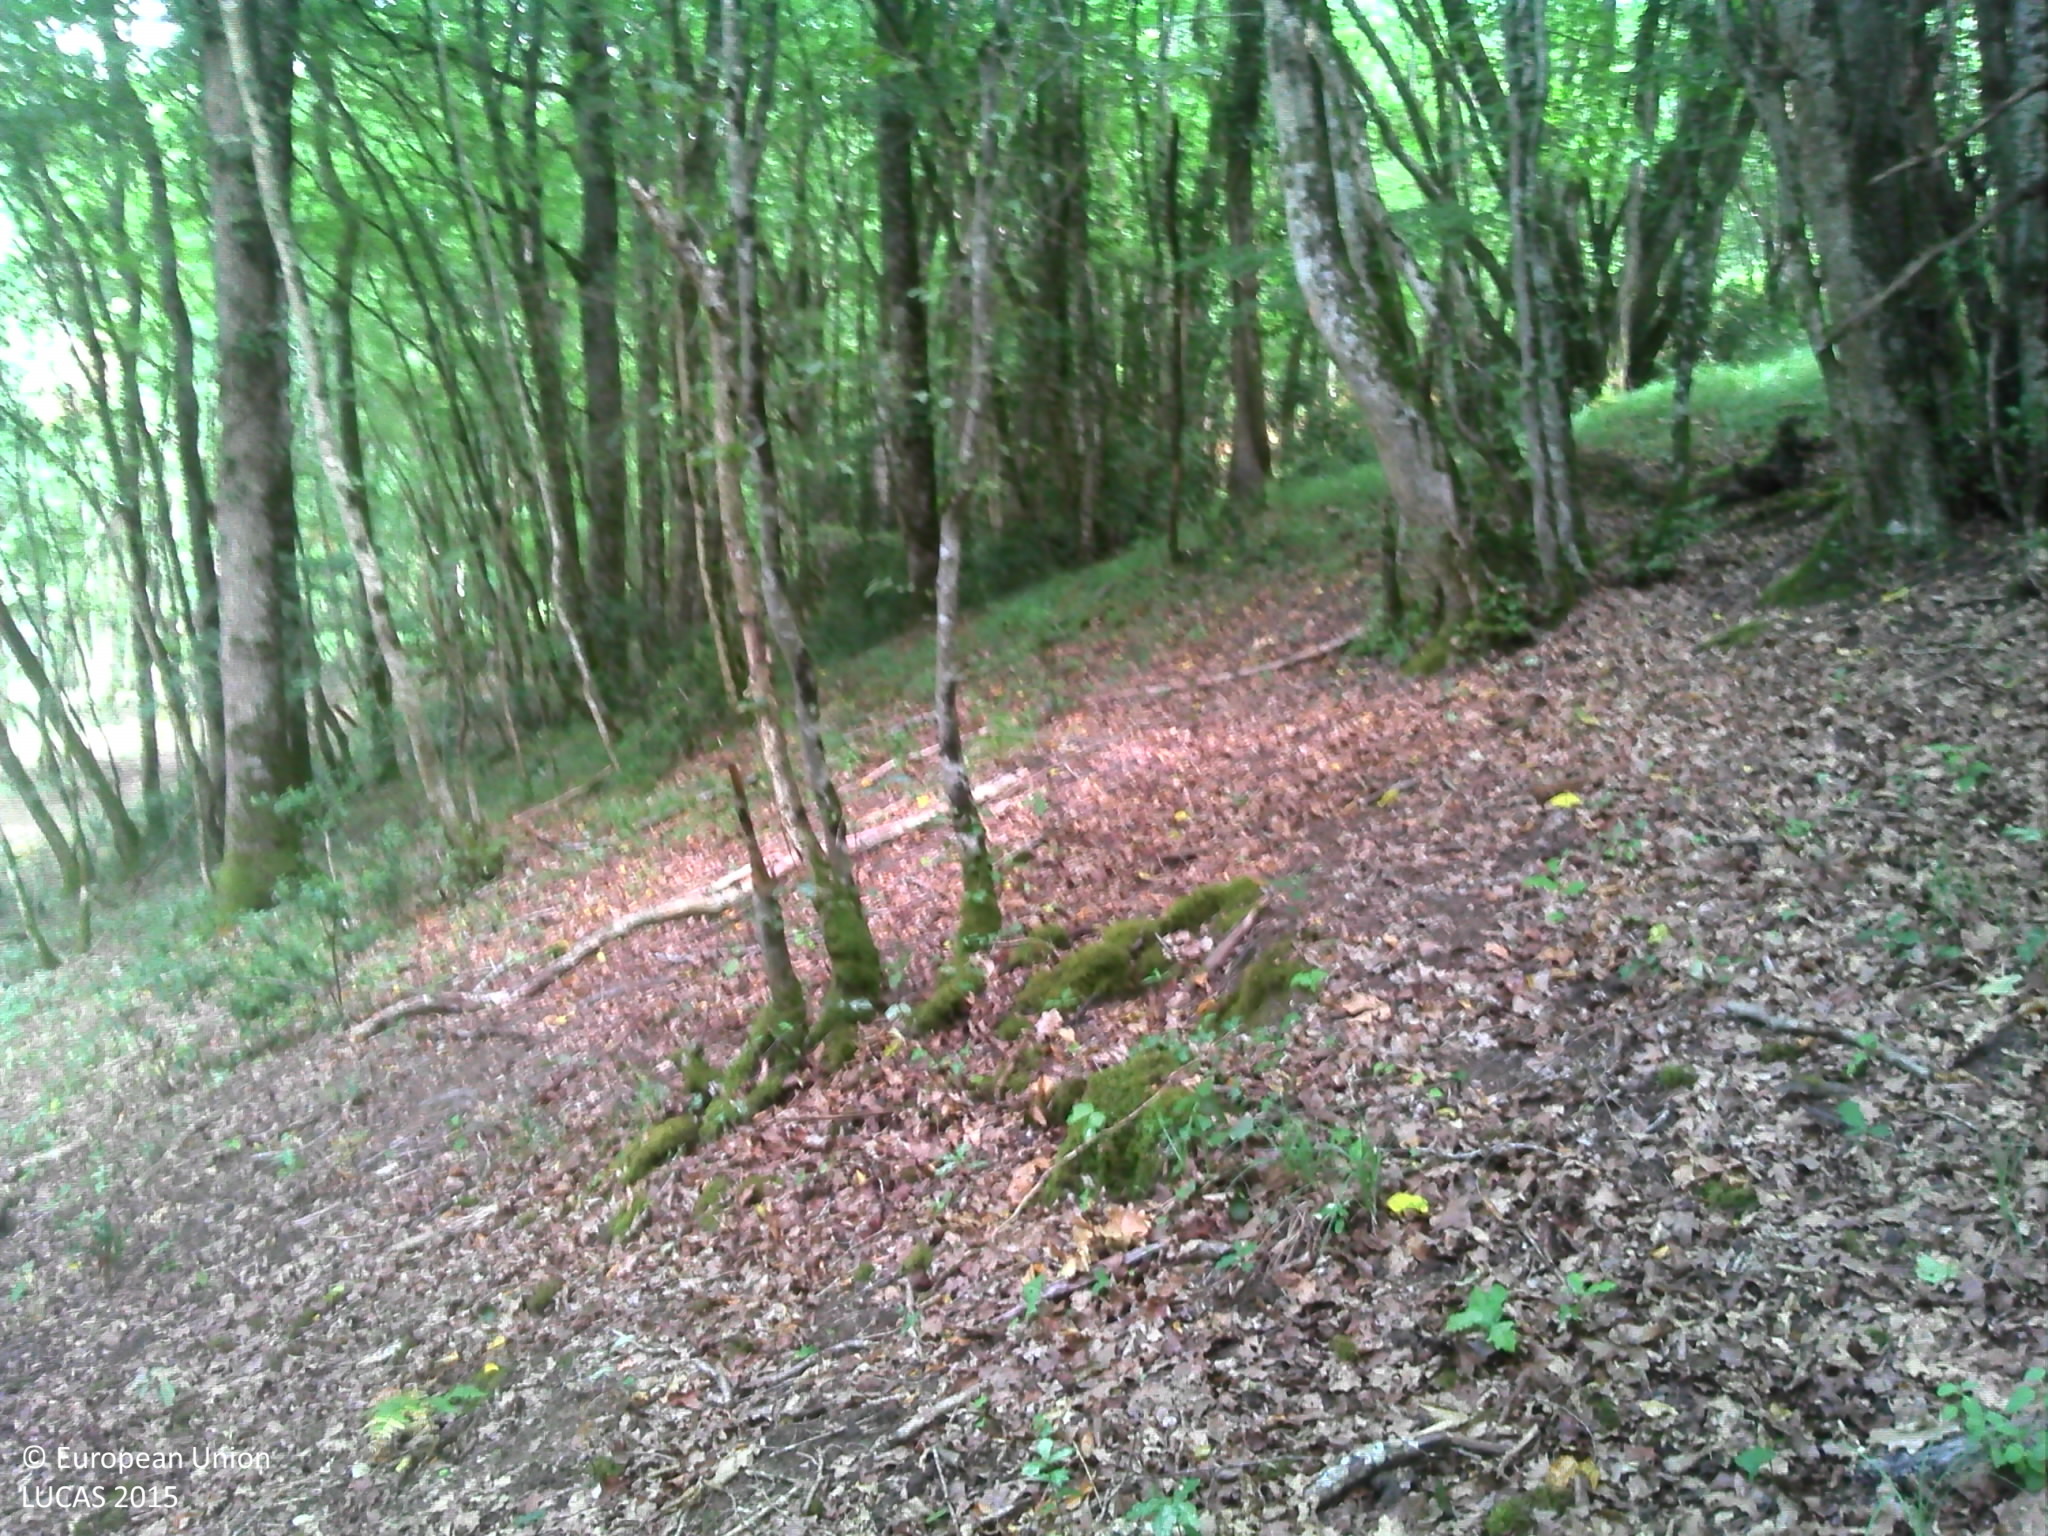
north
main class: Woodland
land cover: Broadleaved woodland
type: mesophytic deciduous forest
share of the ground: > 75 %
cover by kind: broadleaved forest trees 85 %, shrubs 5 %, herbaceous plants 5 %, lichens and mosses 5 %
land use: Forestry
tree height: > 5 m
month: July
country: FR
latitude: 46.8970
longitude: 0.8083
